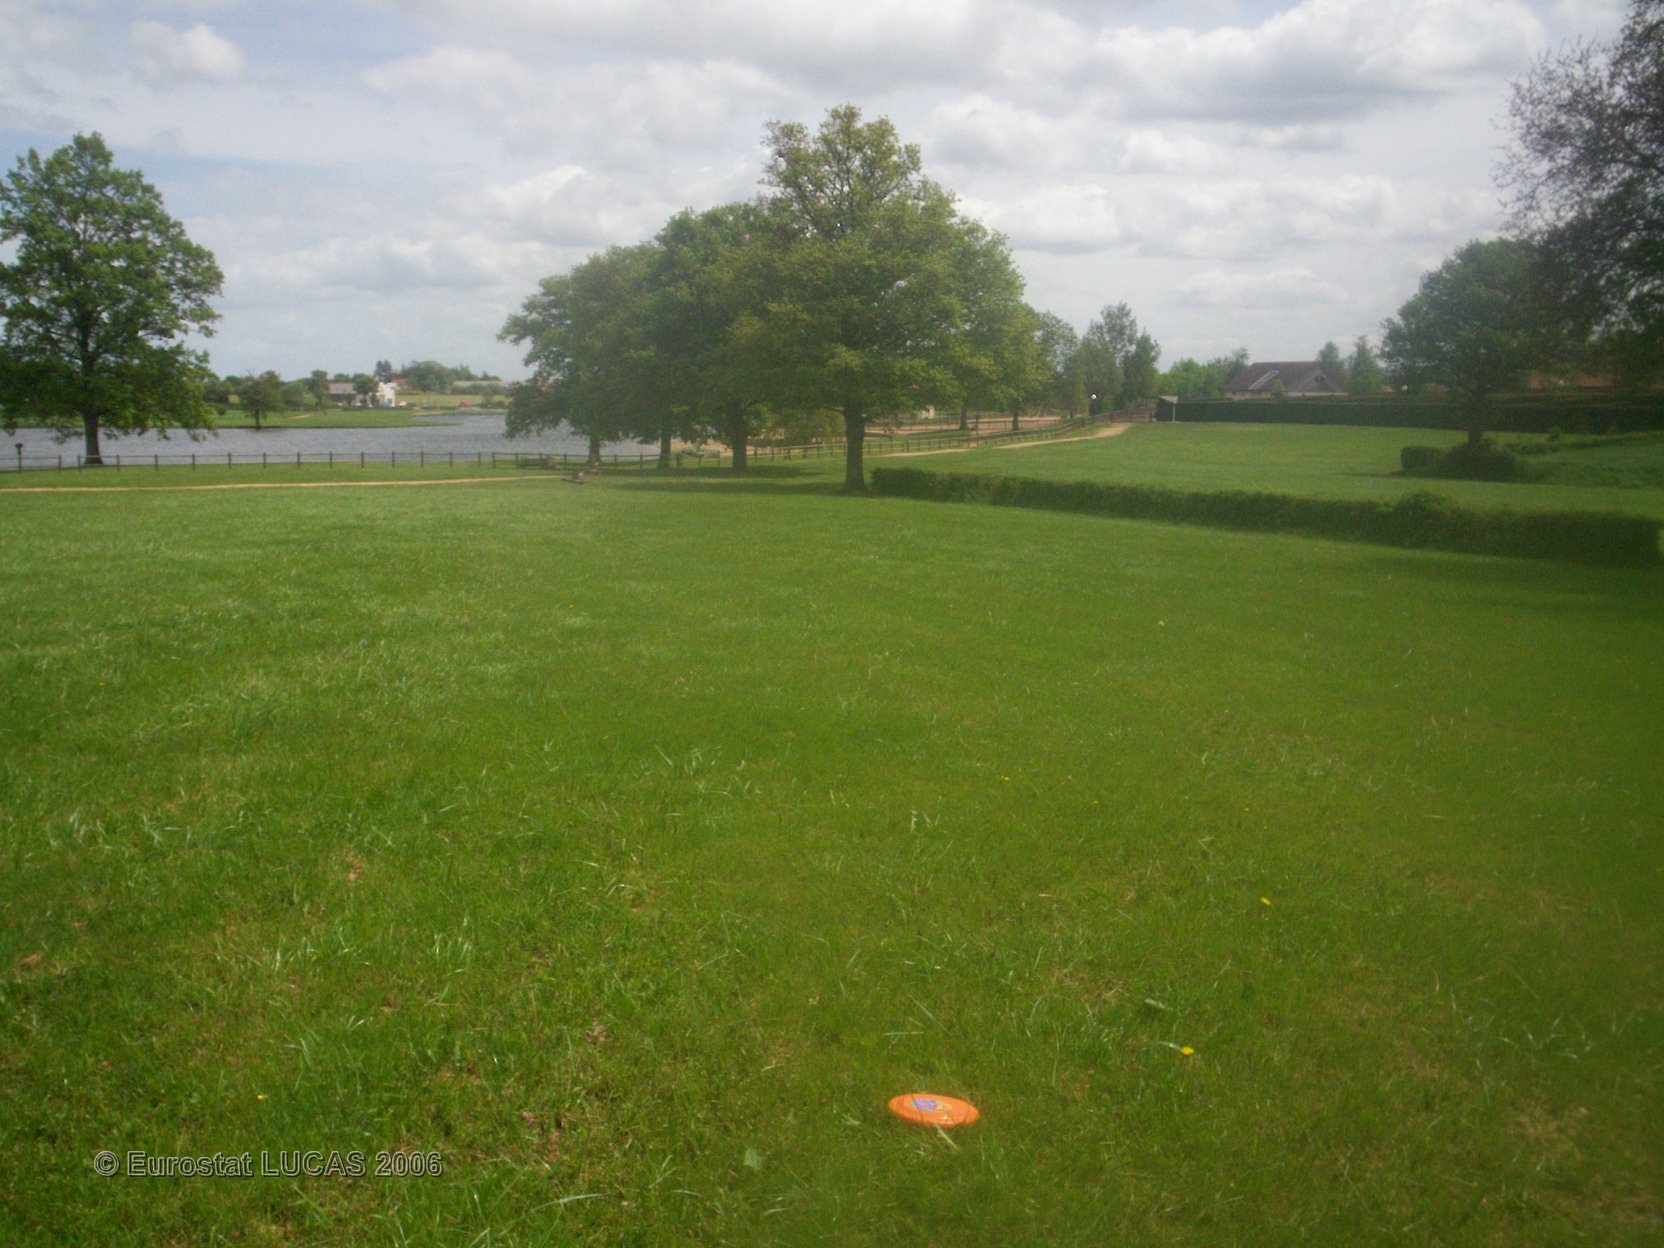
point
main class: Grassland
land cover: Grassland without tree/shrub cover
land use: Agriculture (excluding fallow land and kitchen gardens)
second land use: Amenities, museums, leisure
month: May
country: FR
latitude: 46.2223
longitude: 2.8801
